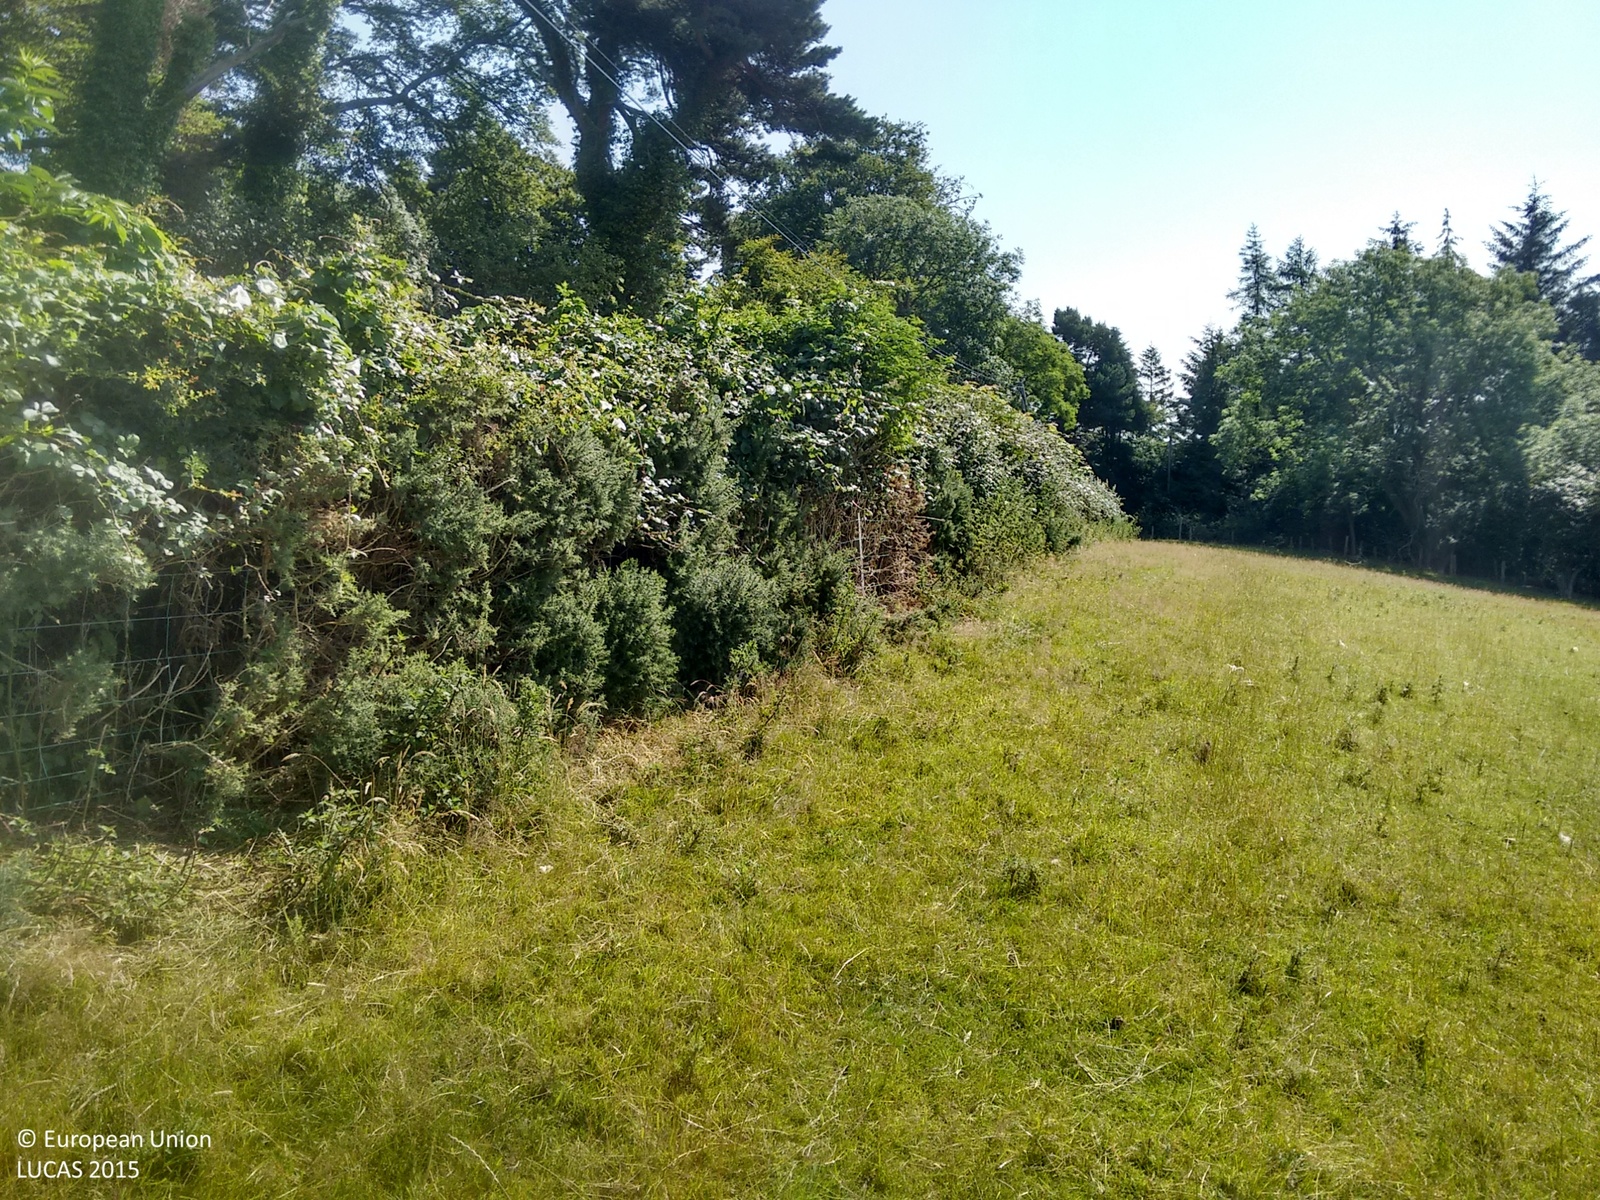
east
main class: Grassland
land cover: Grassland without tree/shrub cover
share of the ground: > 75 %
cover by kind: herbaceous plants 100 %
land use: Agriculture (excluding fallow land and kitchen gardens)
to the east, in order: Grassland without tree/shrub cover; Other mixed woodland; Artificial constructions in urban areas; Other mixed woodland
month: July
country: IE
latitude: 53.1583
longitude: -6.1030
